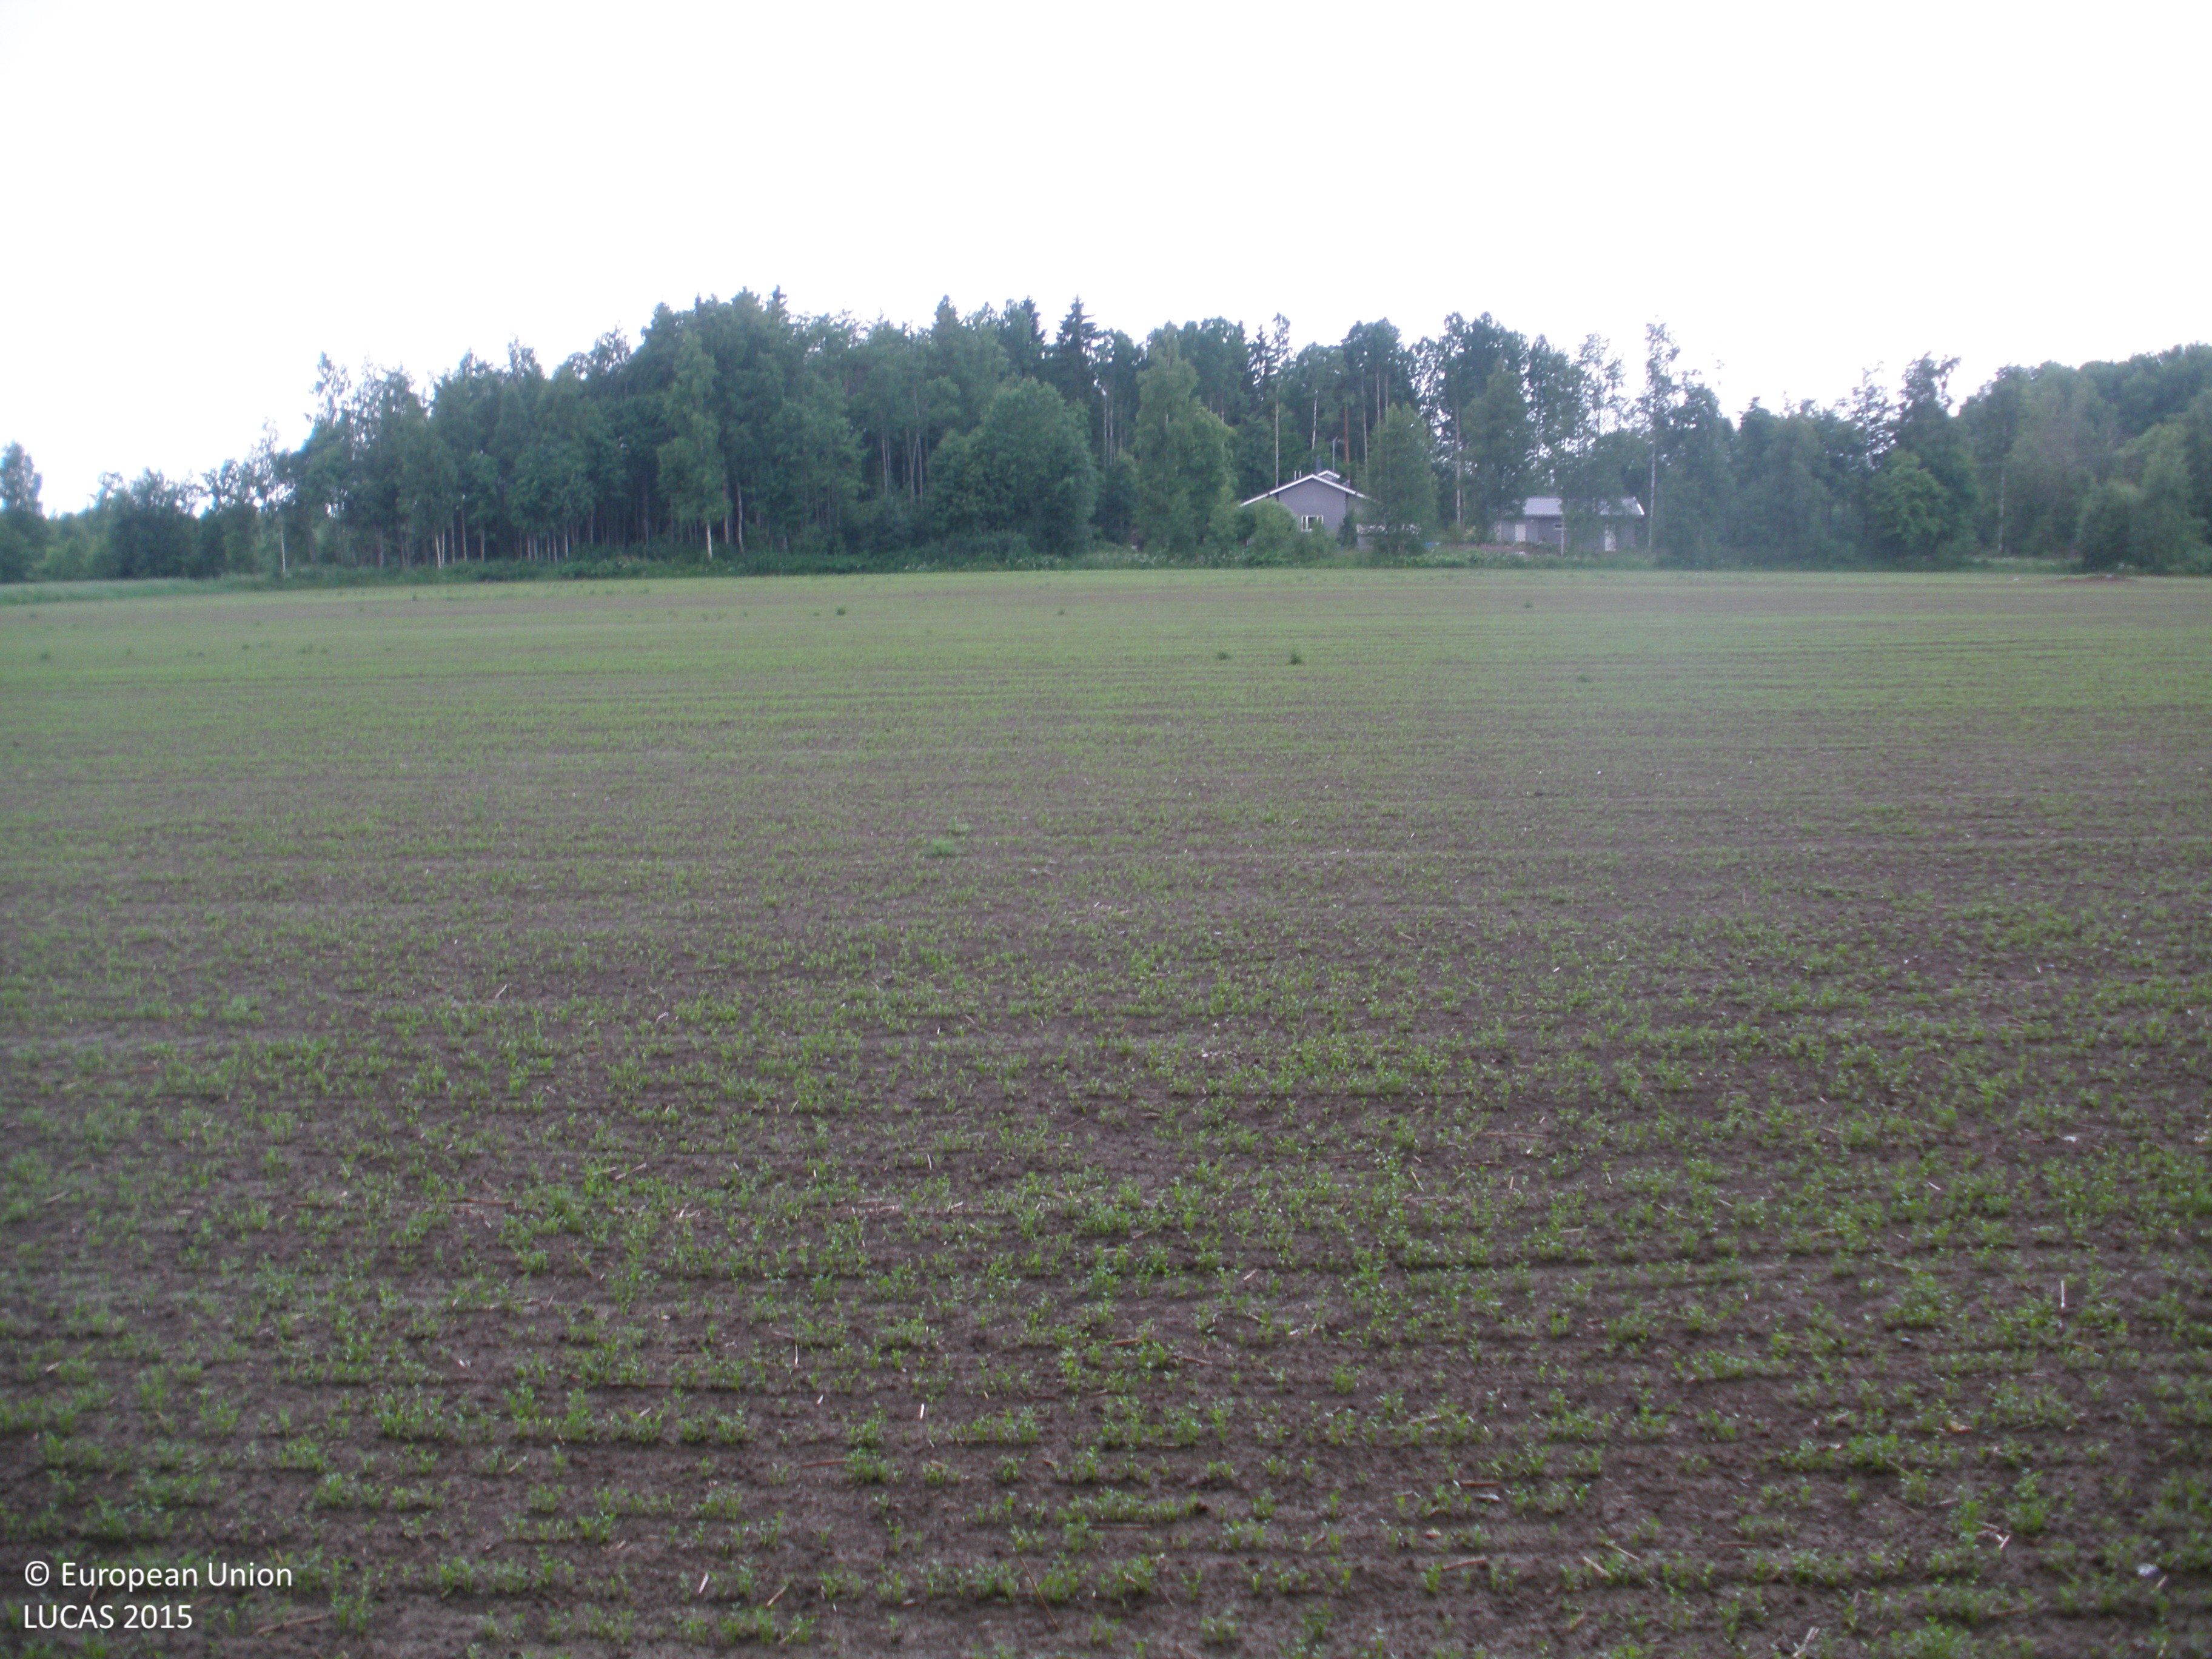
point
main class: Cropland
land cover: Other root crops
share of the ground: 25 - 50 %
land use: Agriculture (excluding fallow land and kitchen gardens)
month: July
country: FI
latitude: 61.4590
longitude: 23.9914
